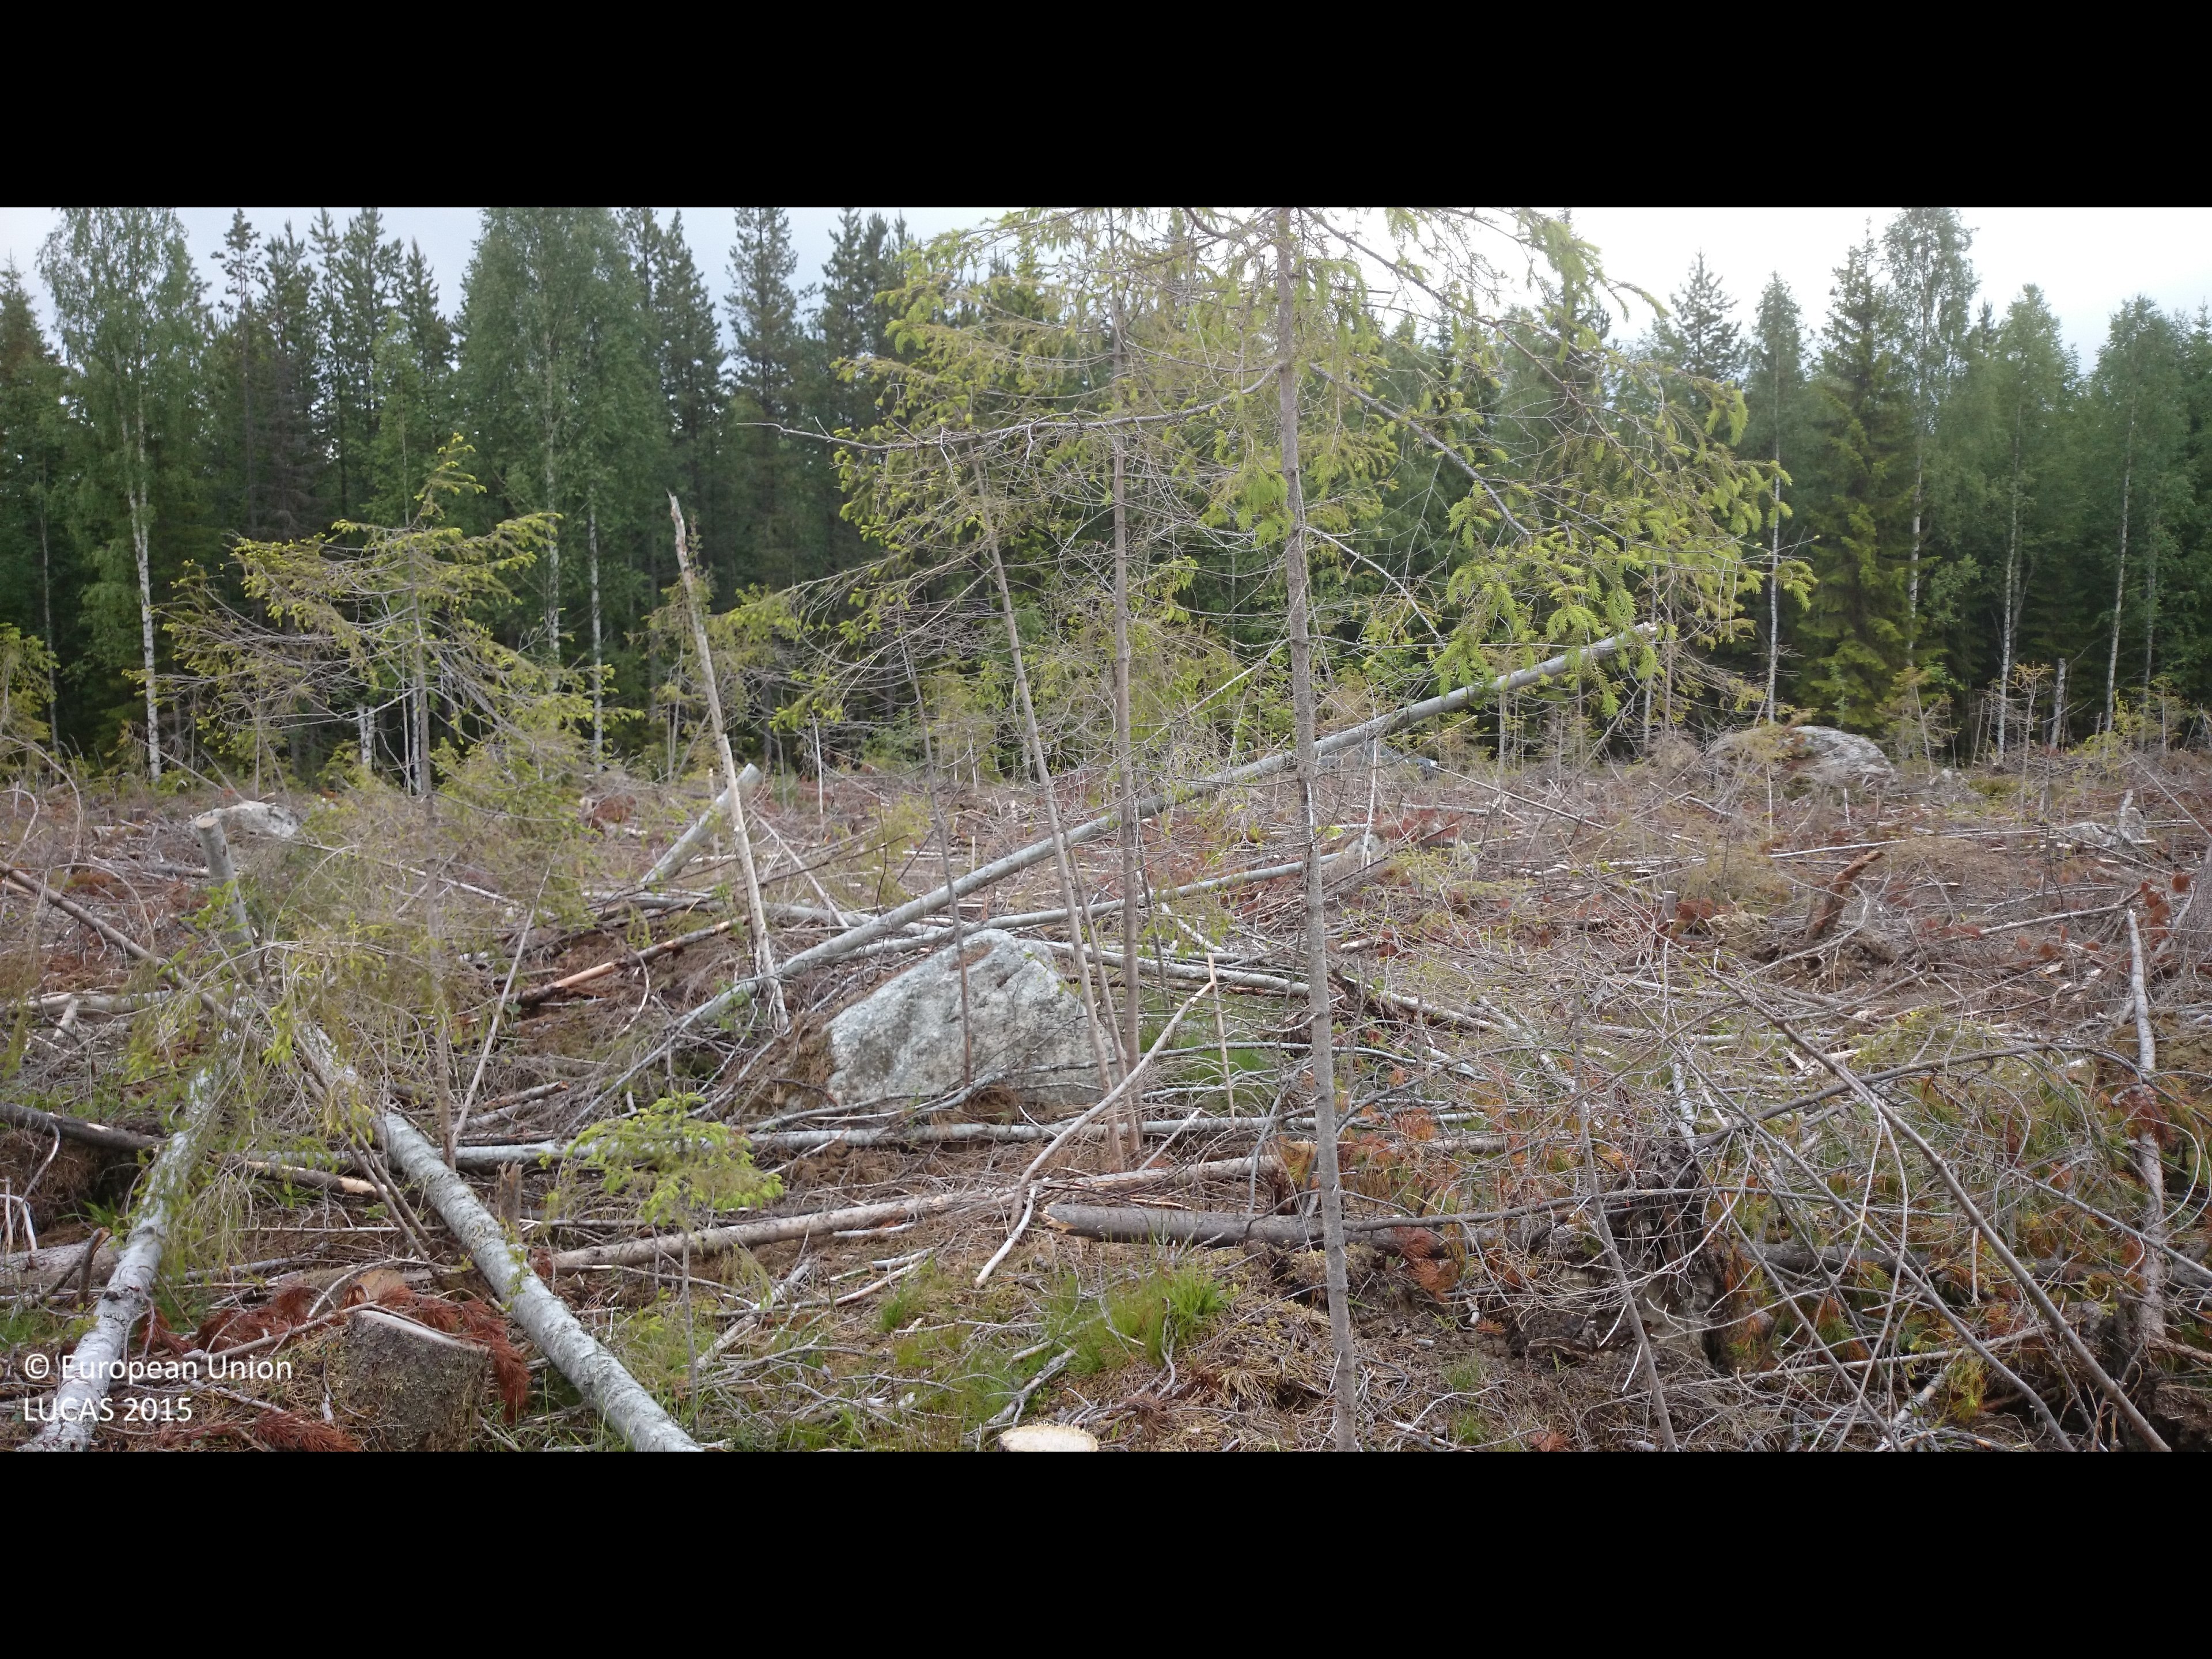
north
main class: Woodland
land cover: Spruce dominated coniferous woodland
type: boreal forest
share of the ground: 10 - 25 %
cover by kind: coniferous forest trees 30 %
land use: Forestry
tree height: < 5 m
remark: Clear cut
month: June
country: SE
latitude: 62.0761
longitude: 16.8534
